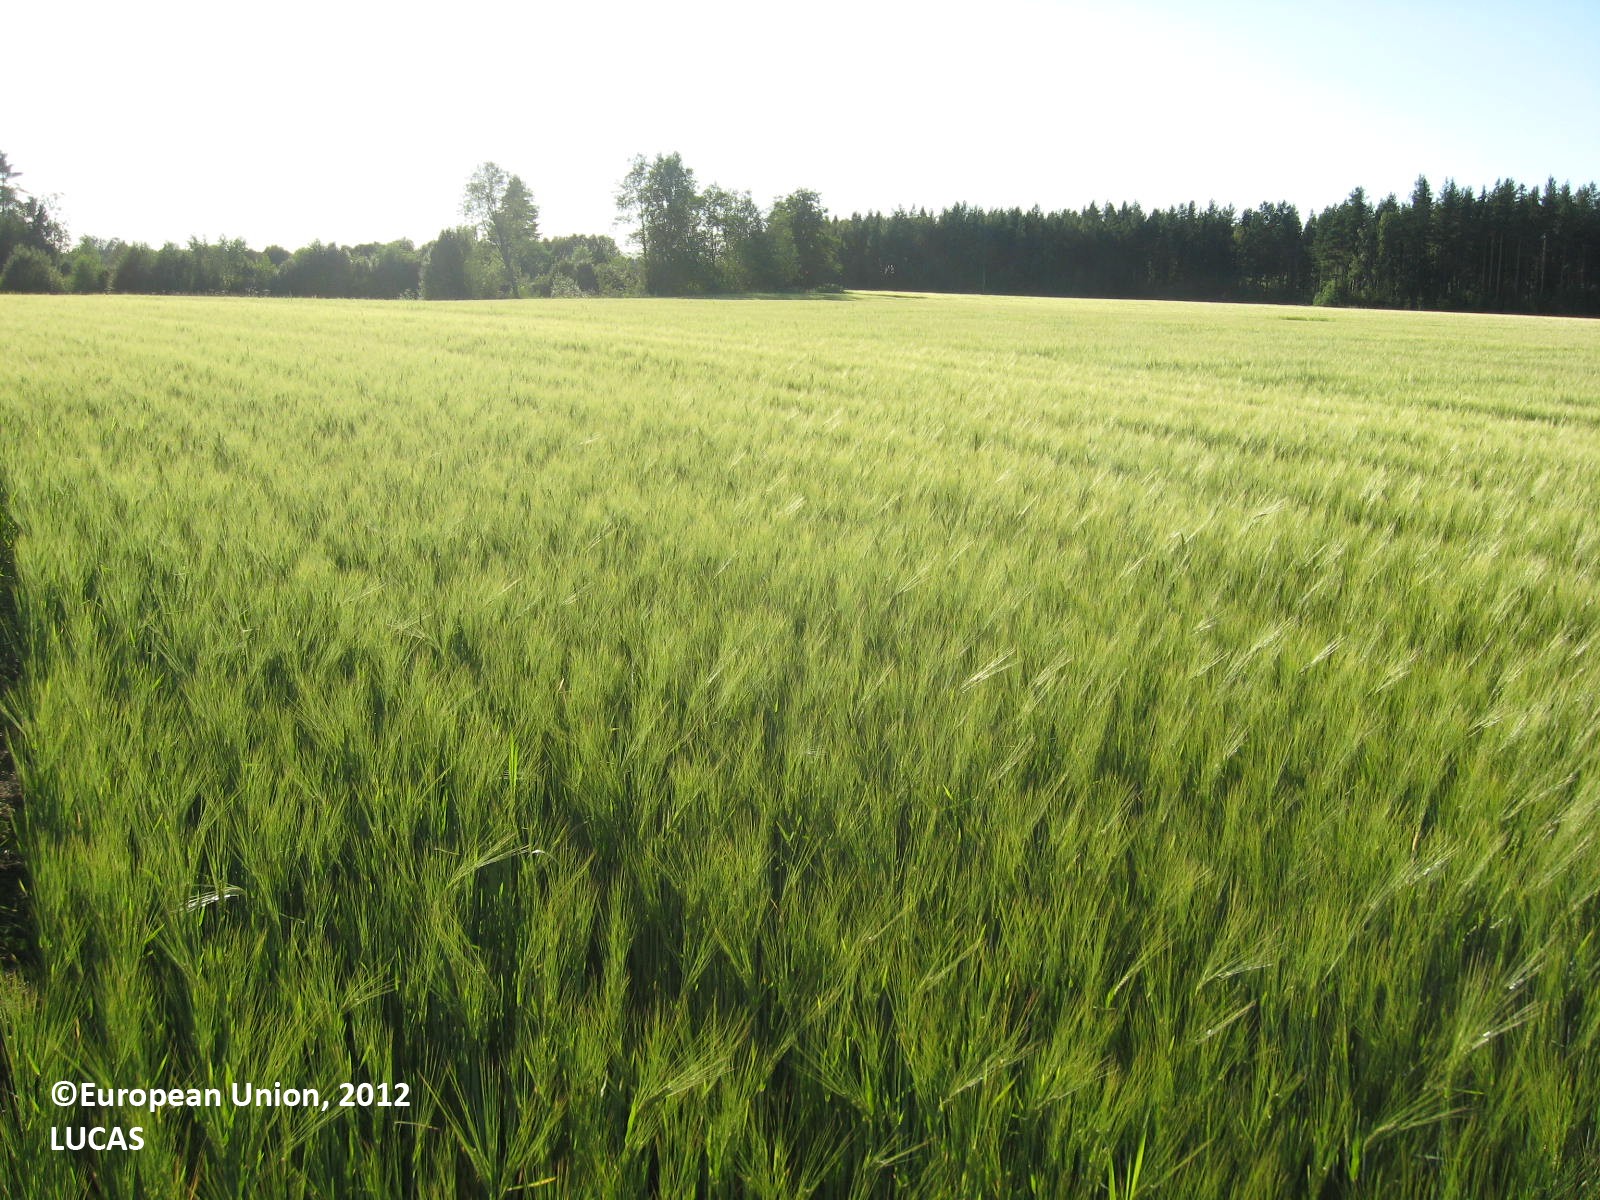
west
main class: Cropland
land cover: Barley
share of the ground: > 75 %
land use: Agriculture (excluding fallow land and kitchen gardens)
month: July
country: FI
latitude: 62.0725
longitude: 22.4802
